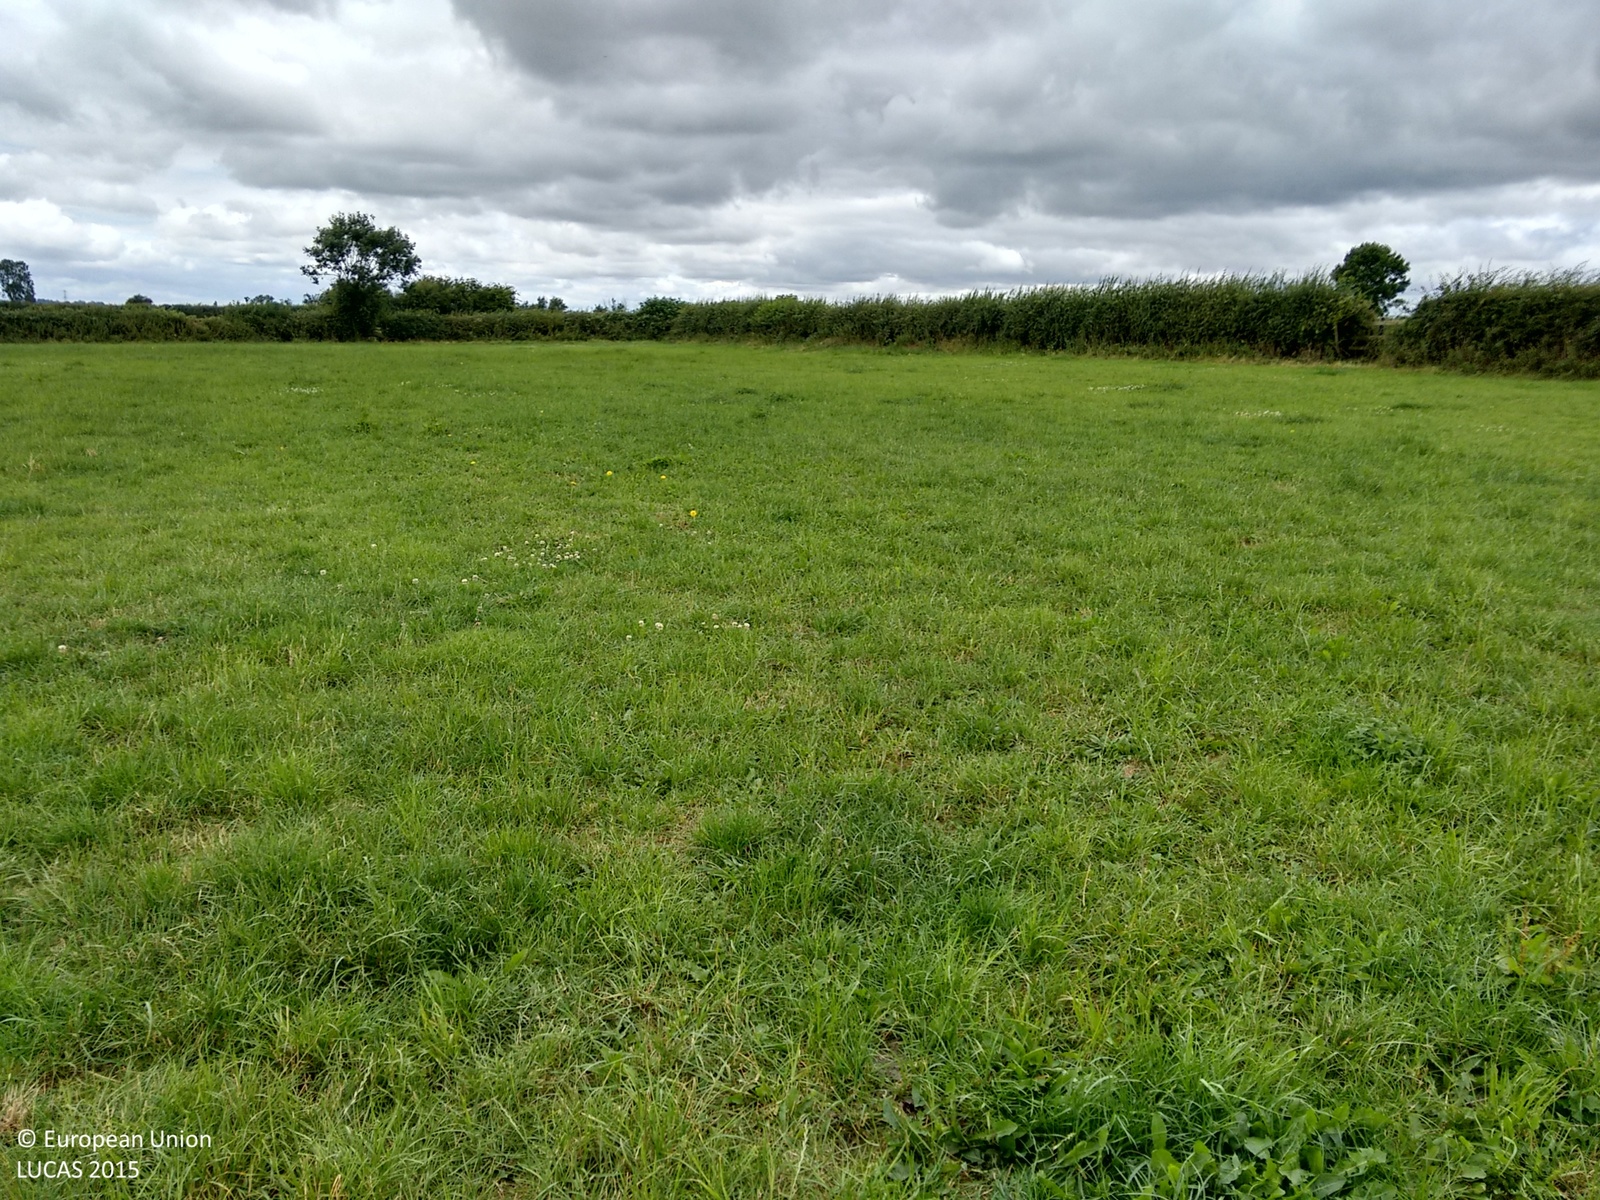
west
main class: Grassland
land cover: Grassland without tree/shrub cover
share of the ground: > 75 %
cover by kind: herbaceous plants 100 %
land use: Agriculture (excluding fallow land and kitchen gardens)
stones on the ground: < 10 %
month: July
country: GB
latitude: 52.8513
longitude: -0.9278
